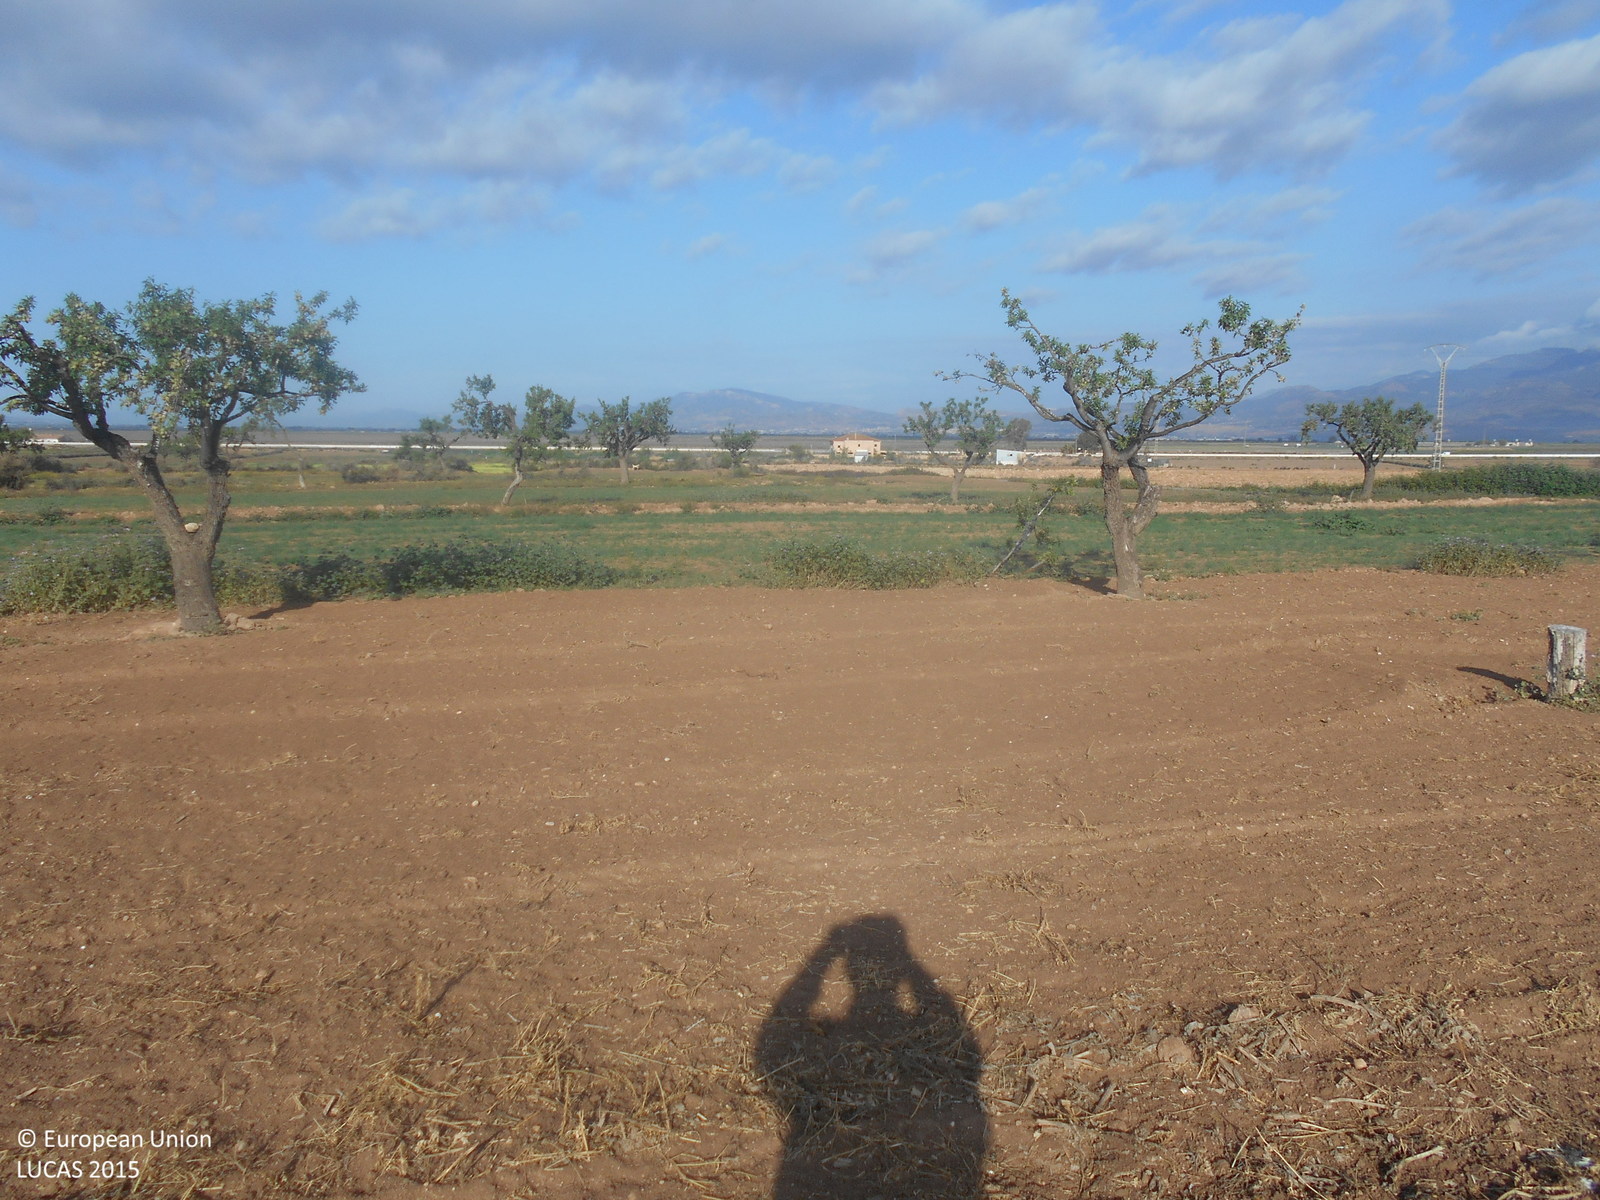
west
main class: Cropland
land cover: Nuts trees
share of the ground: < 10 %
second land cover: Other bare soil
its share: > 75 %
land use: Agriculture (excluding fallow land and kitchen gardens)
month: April
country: ES
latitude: 37.7589
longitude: -1.3670
